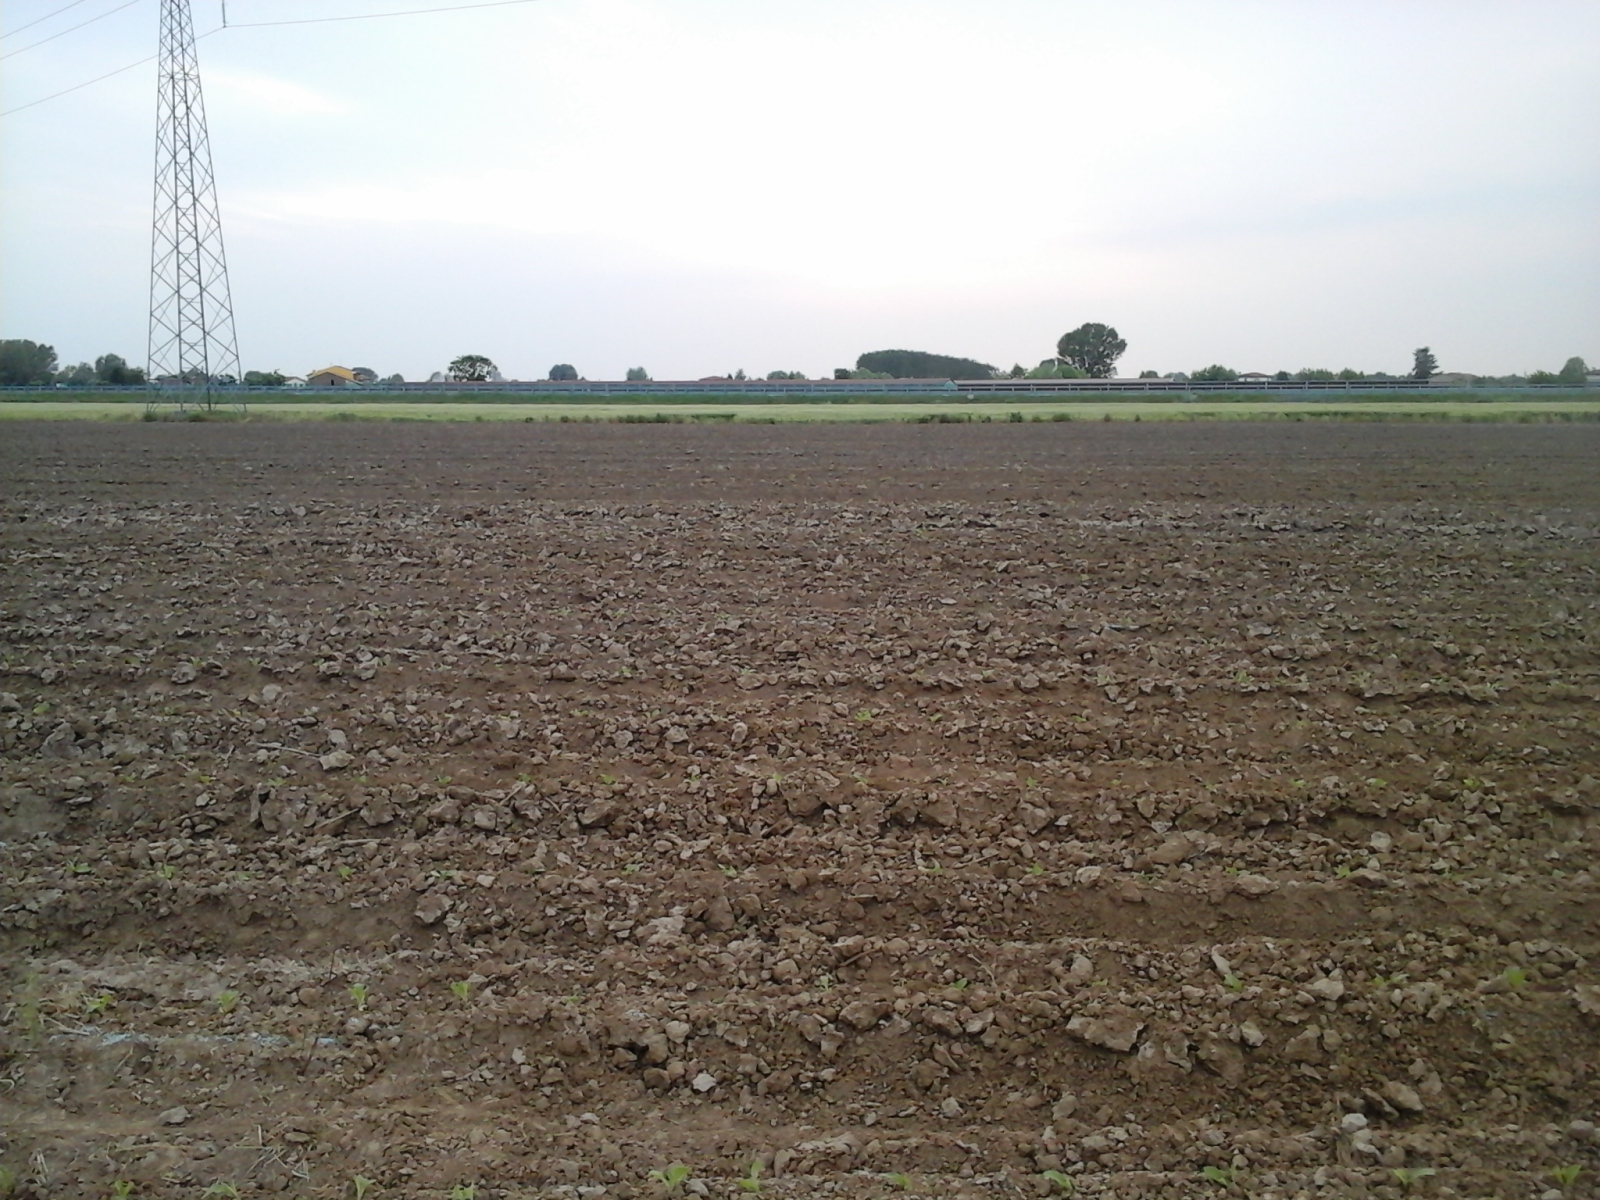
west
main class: Cropland
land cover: Tobacco
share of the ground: < 10 %
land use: Agriculture (excluding fallow land and kitchen gardens)
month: May
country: IT
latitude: 45.2405
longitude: 11.5642
